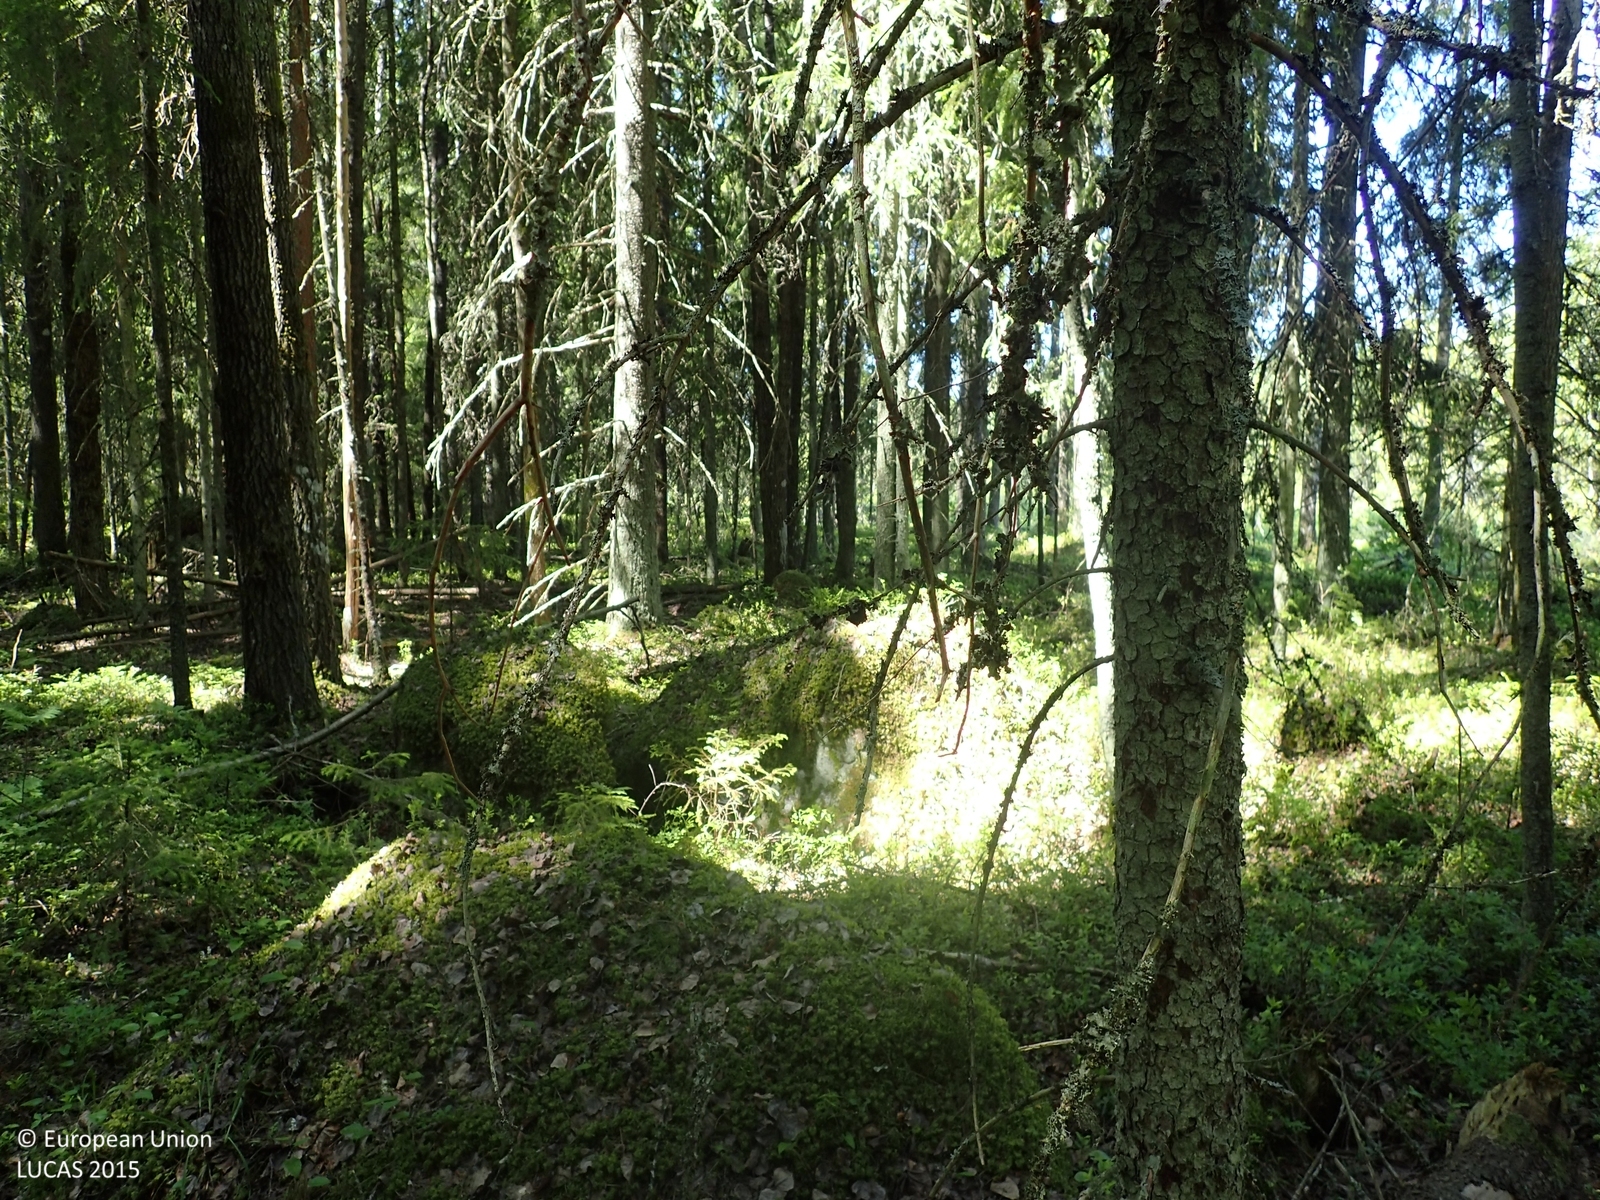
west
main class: Woodland
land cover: Spruce dominated mixed woodland
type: boreal forest
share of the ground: > 75 %
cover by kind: coniferous forest trees 60 %, broadleaved forest trees 20 %, shrubs 15 %, lichens and mosses 5 %
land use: Forestry
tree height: > 5 m
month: July
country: FI
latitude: 62.5509
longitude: 21.5358
